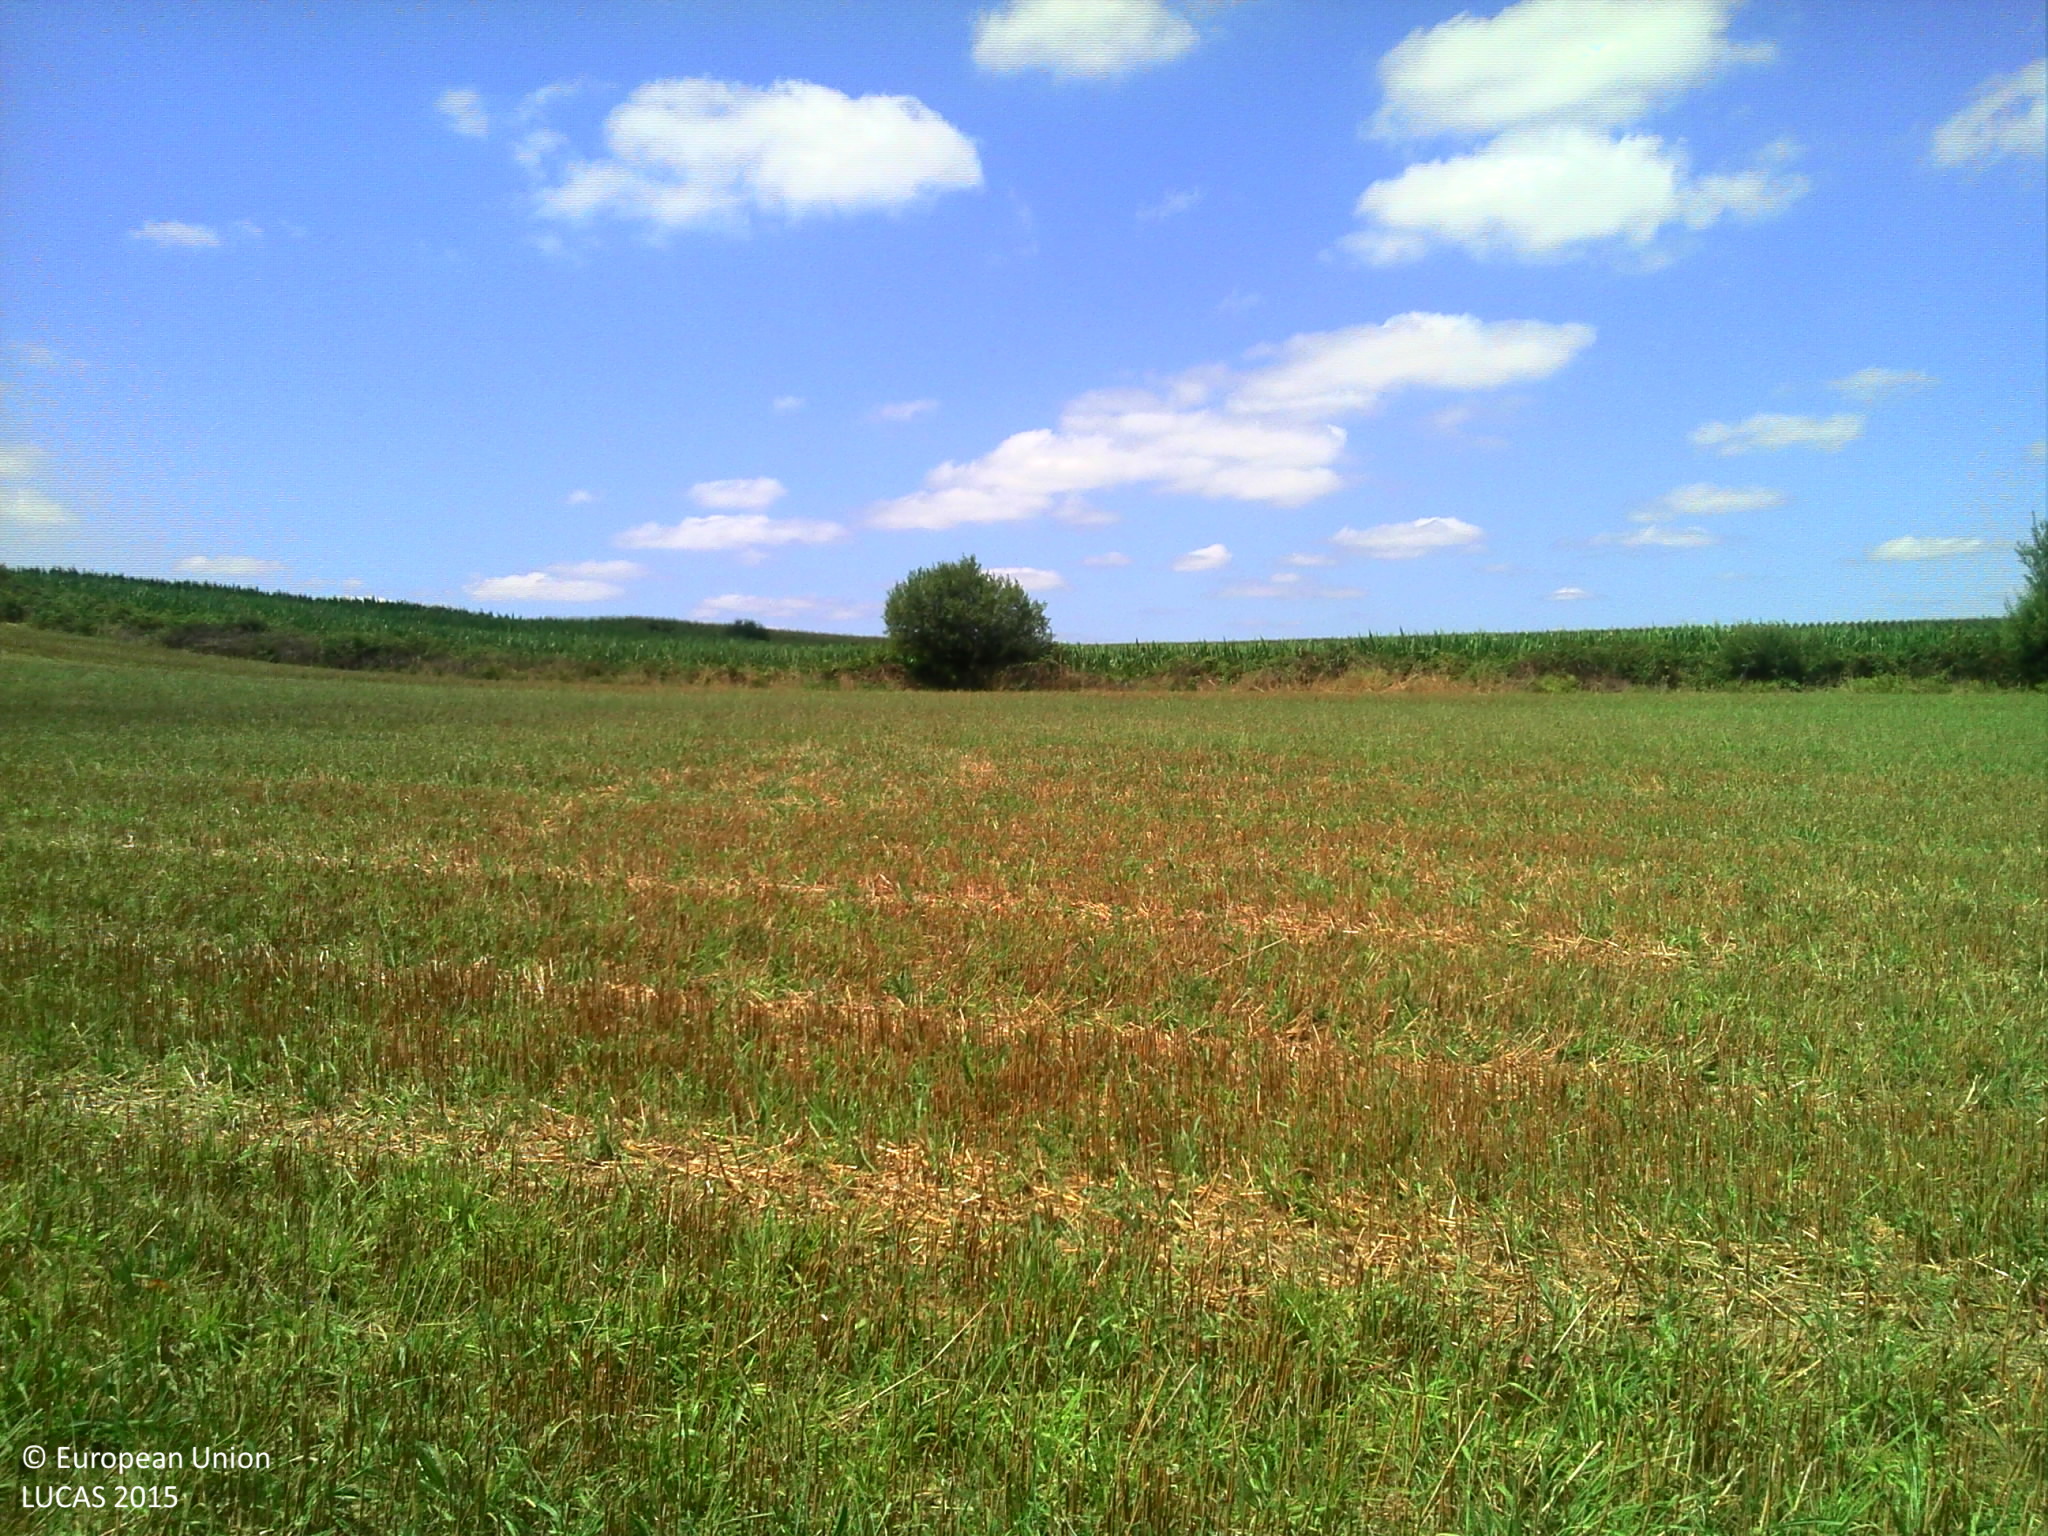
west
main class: Cropland
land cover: Temporary grasslands
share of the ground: > 75 %
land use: Agriculture (excluding fallow land and kitchen gardens)
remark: Harvested field
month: July
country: FR
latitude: 43.5181
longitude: -1.0868
